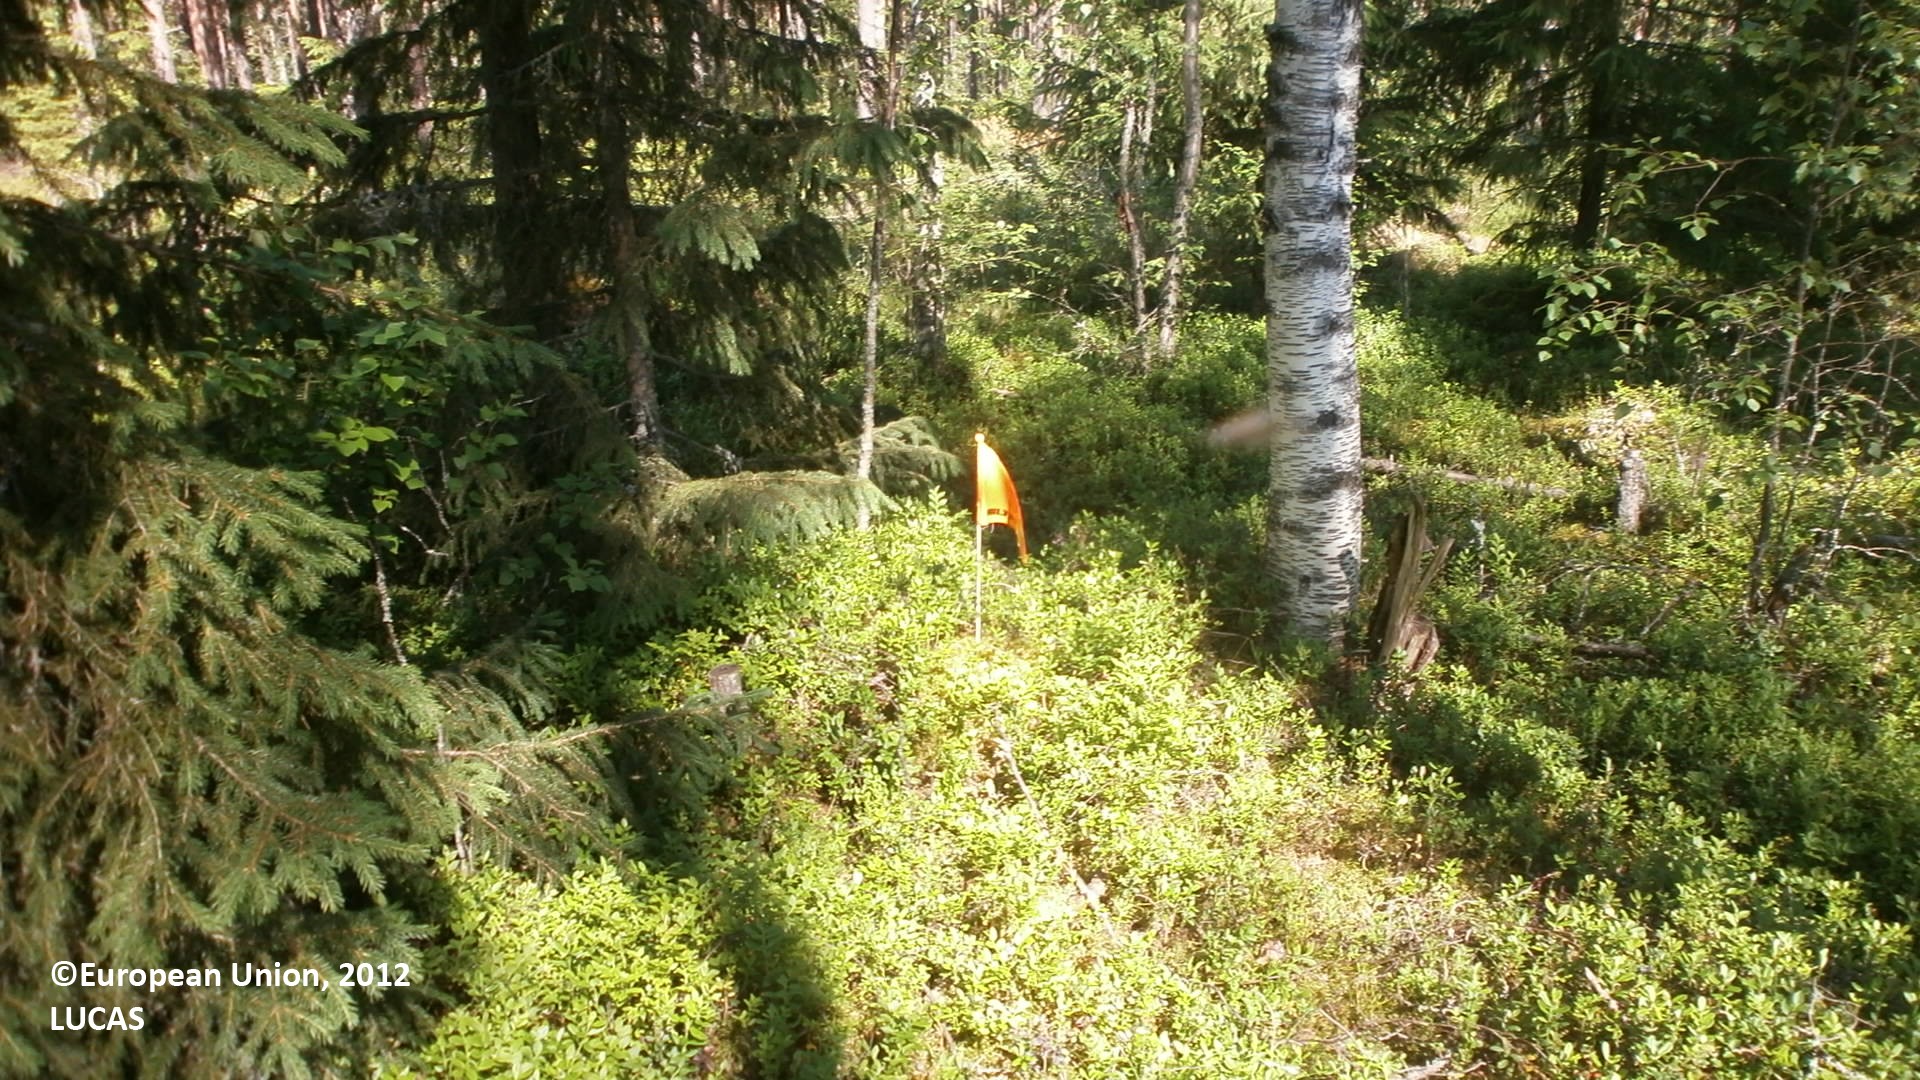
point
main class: Woodland
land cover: Pine dominated mixed woodland
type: boreal forest
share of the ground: 50 - 75 %
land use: Forestry
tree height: > 5 m
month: July
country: FI
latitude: 64.3727
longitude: 24.0920
